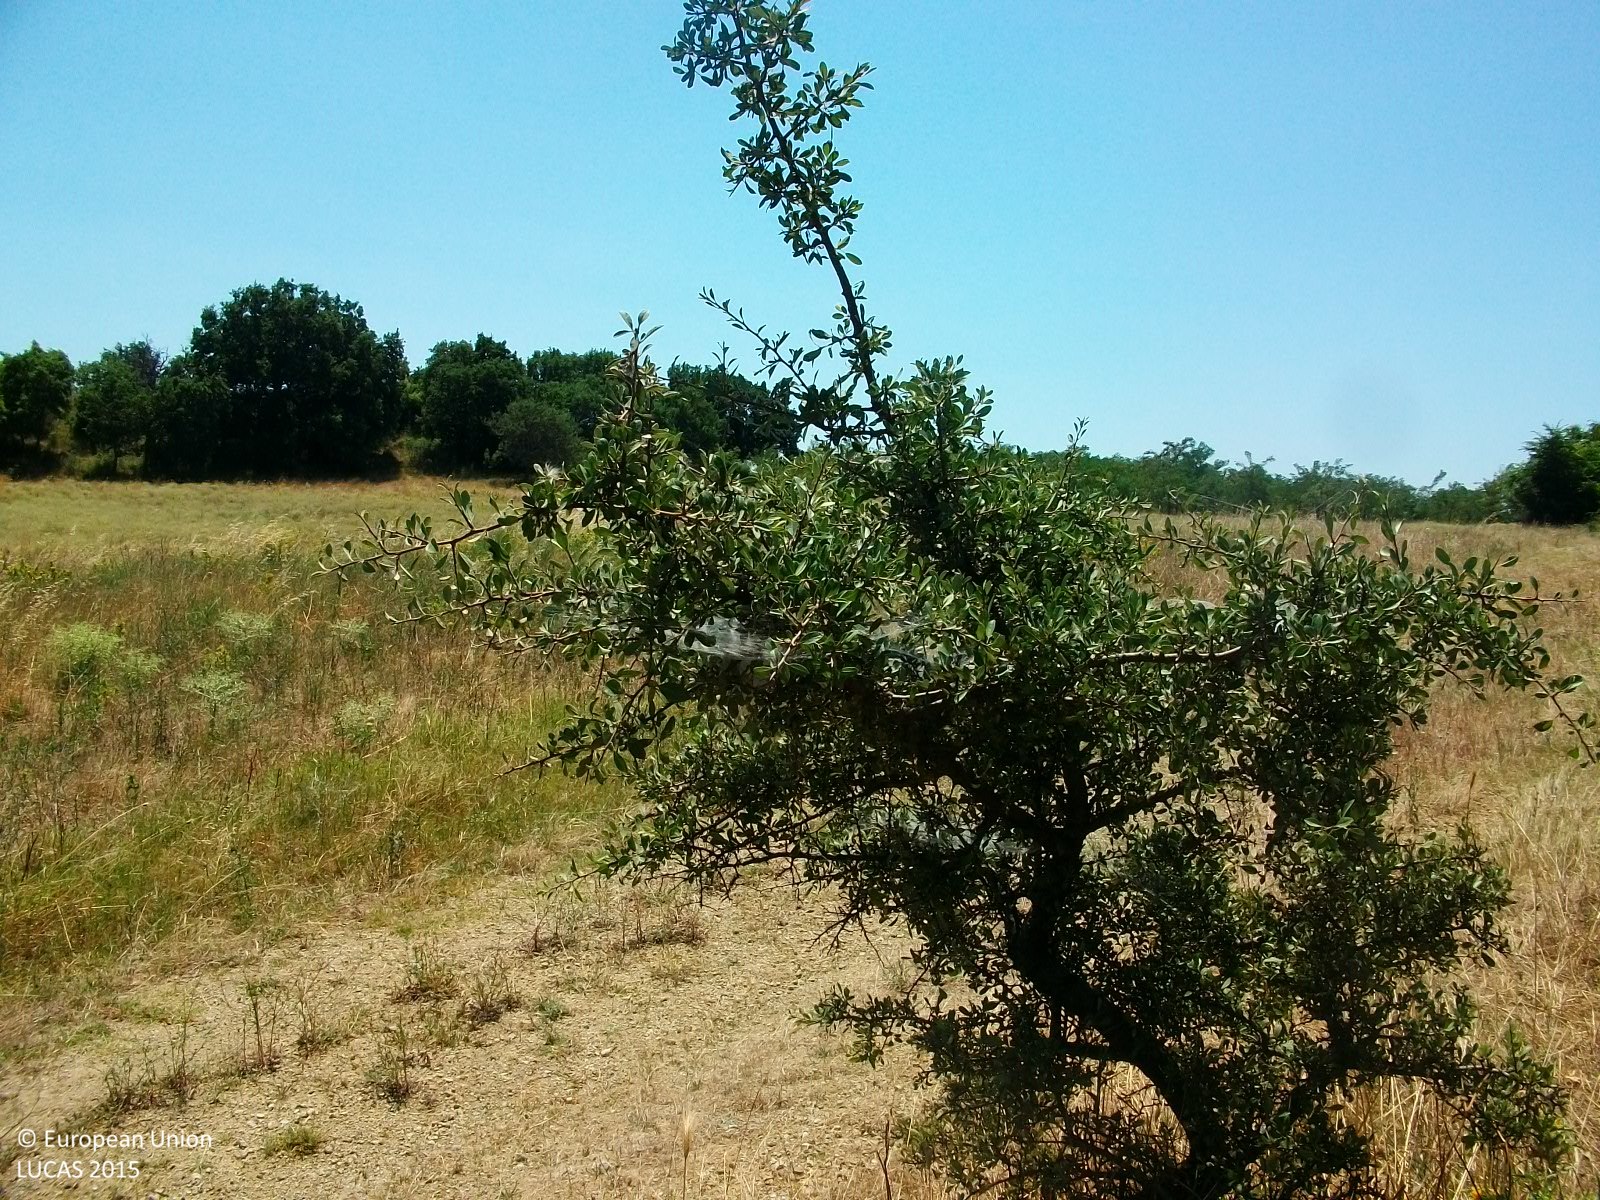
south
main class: Grassland
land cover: Grassland with sparse tree/shrub cover
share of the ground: > 75 %
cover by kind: herbaceous plants 85 %, shrubs 10 %, broadleaved forest trees 5 %
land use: Semi-natural and natural areas not in use
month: July
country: GR
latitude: 40.9145
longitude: 26.1023
